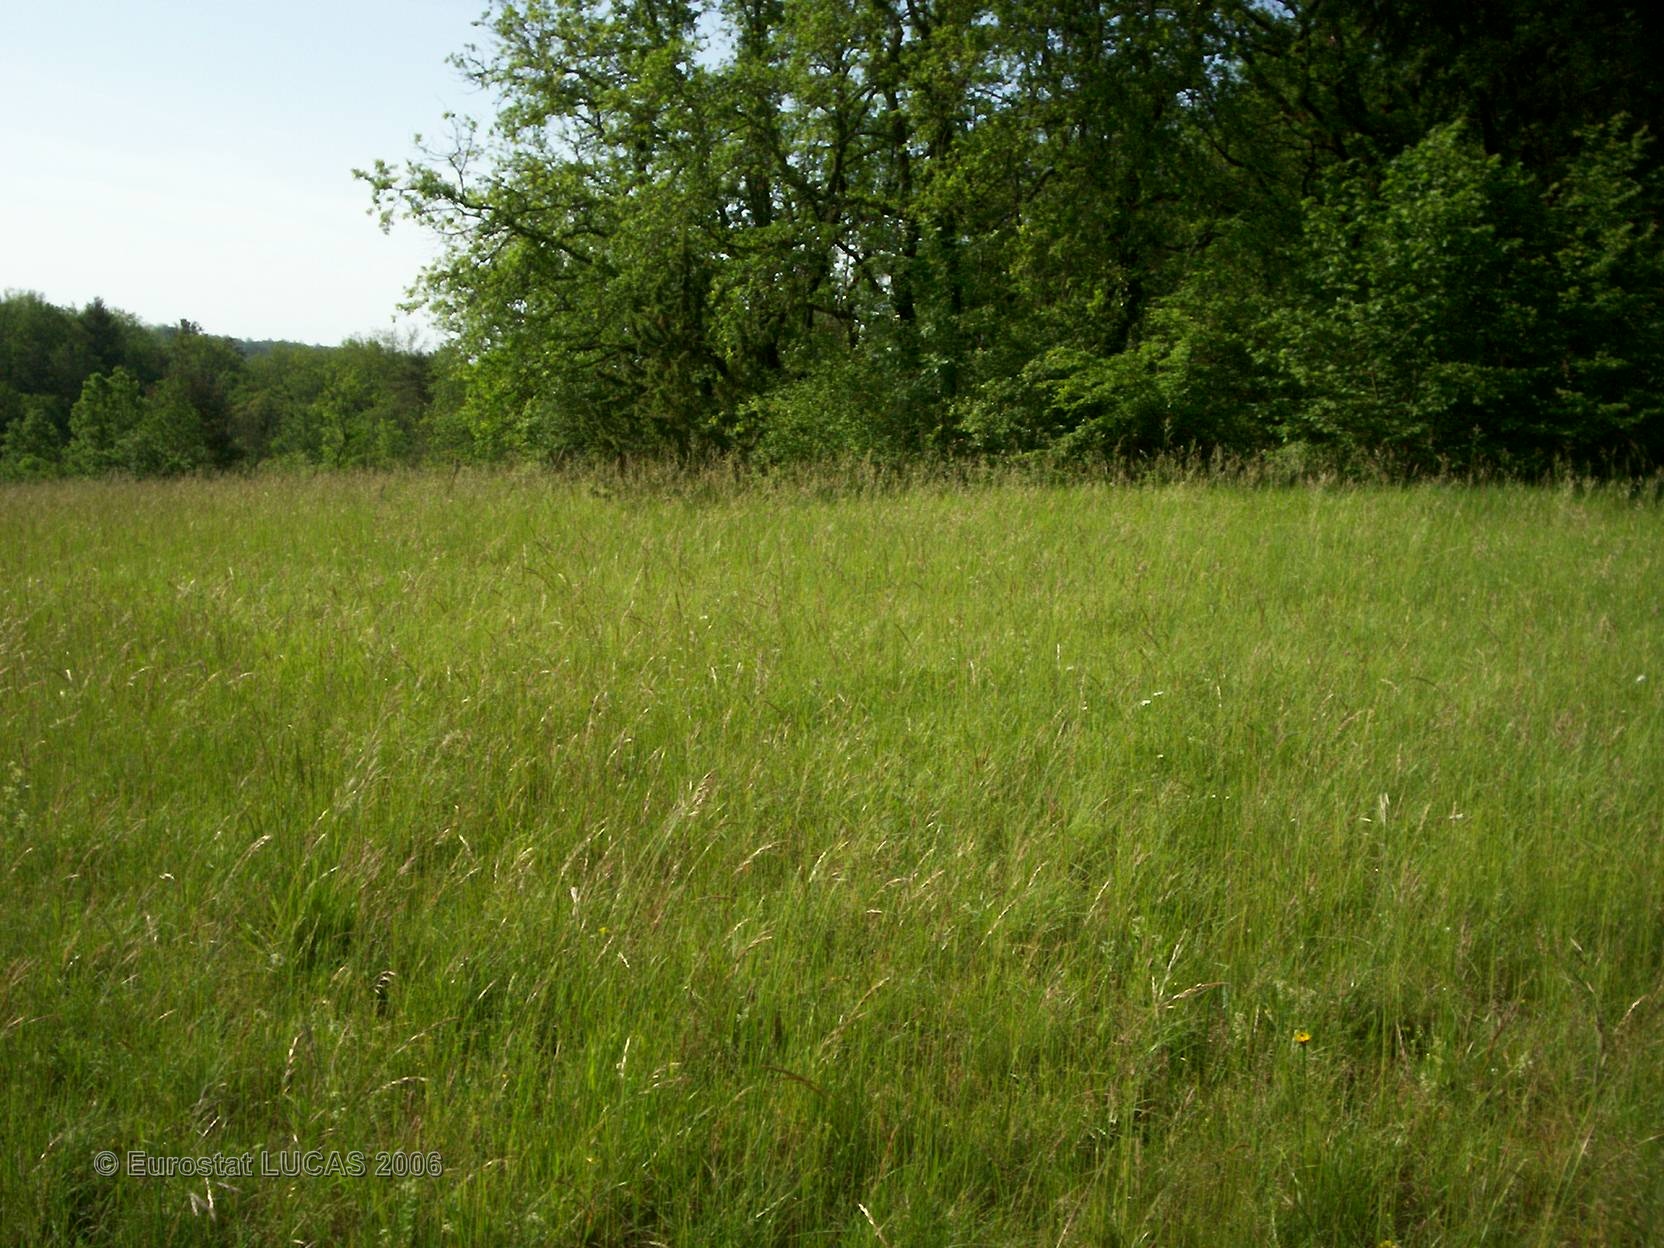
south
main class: Grassland
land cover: Grassland without tree/shrub cover
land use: Agriculture (excluding fallow land and kitchen gardens)
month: May
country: FR
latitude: 45.3590
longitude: 0.6313
